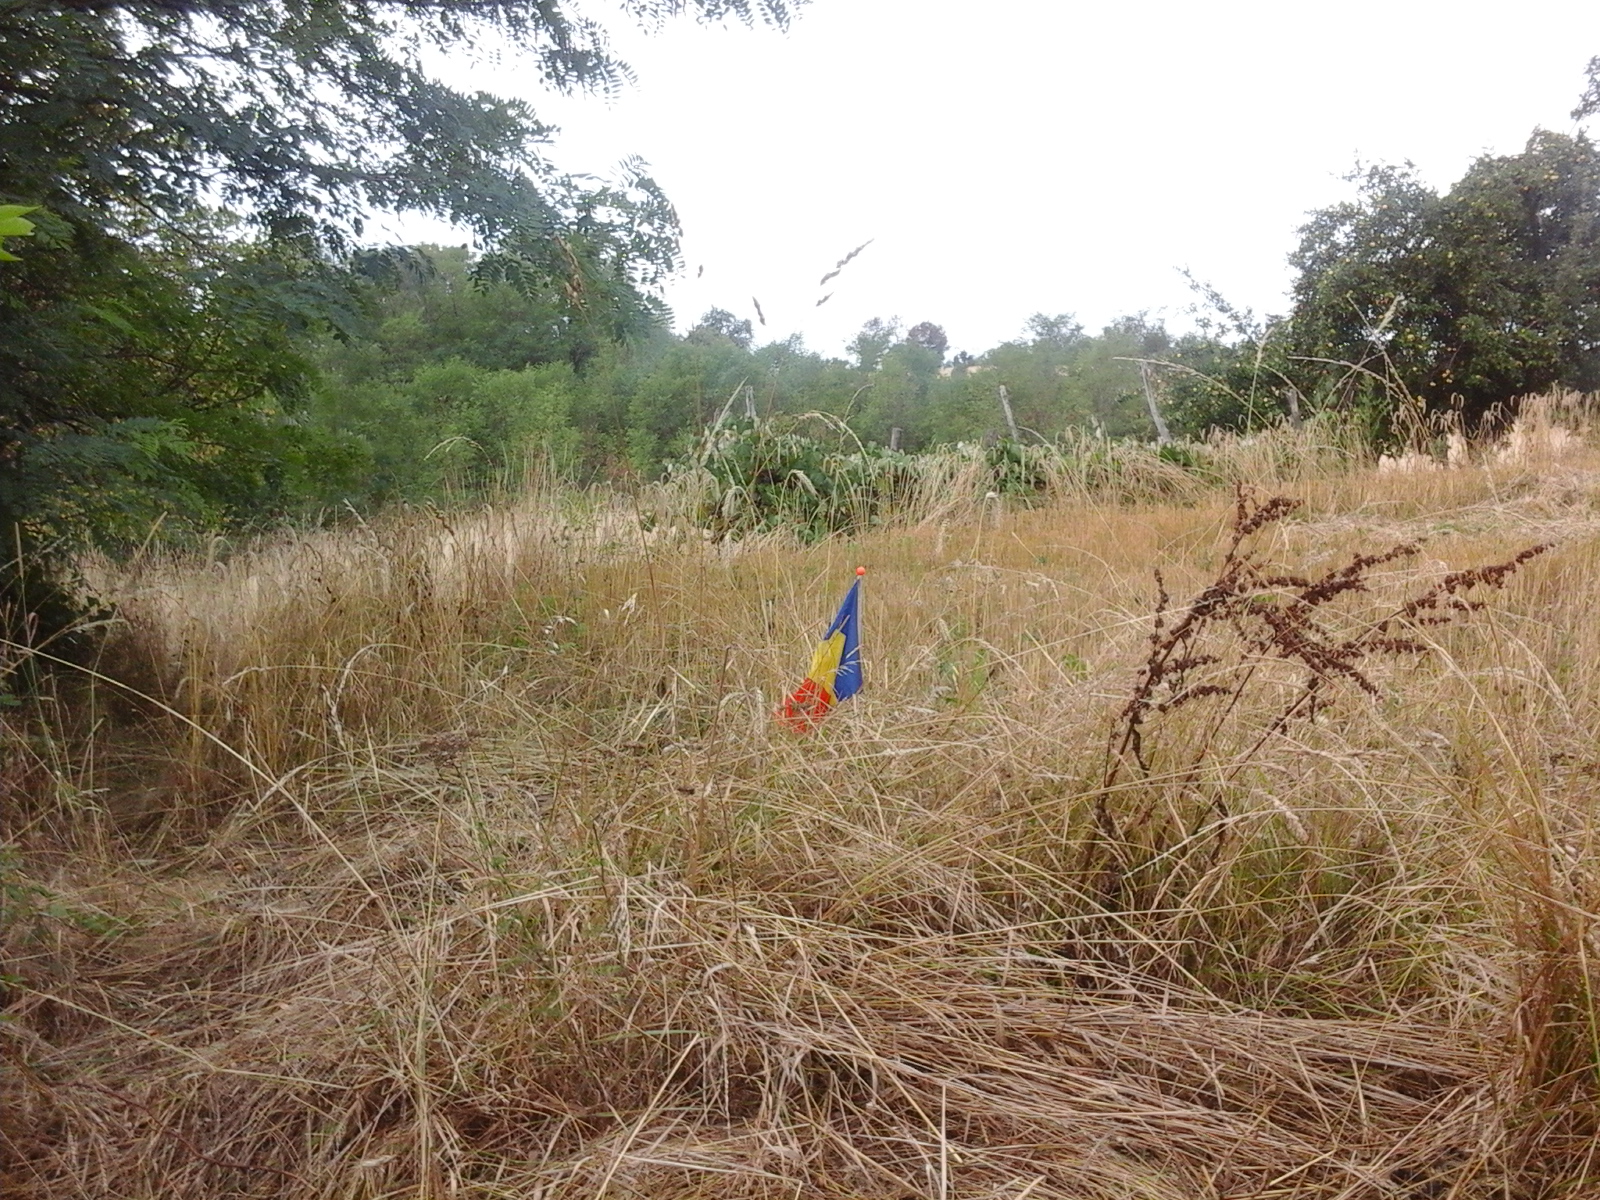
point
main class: Cropland
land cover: Common wheat
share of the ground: > 75 %
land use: Agriculture (excluding fallow land and kitchen gardens)
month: August
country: RO
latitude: 45.2151
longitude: 21.8645
